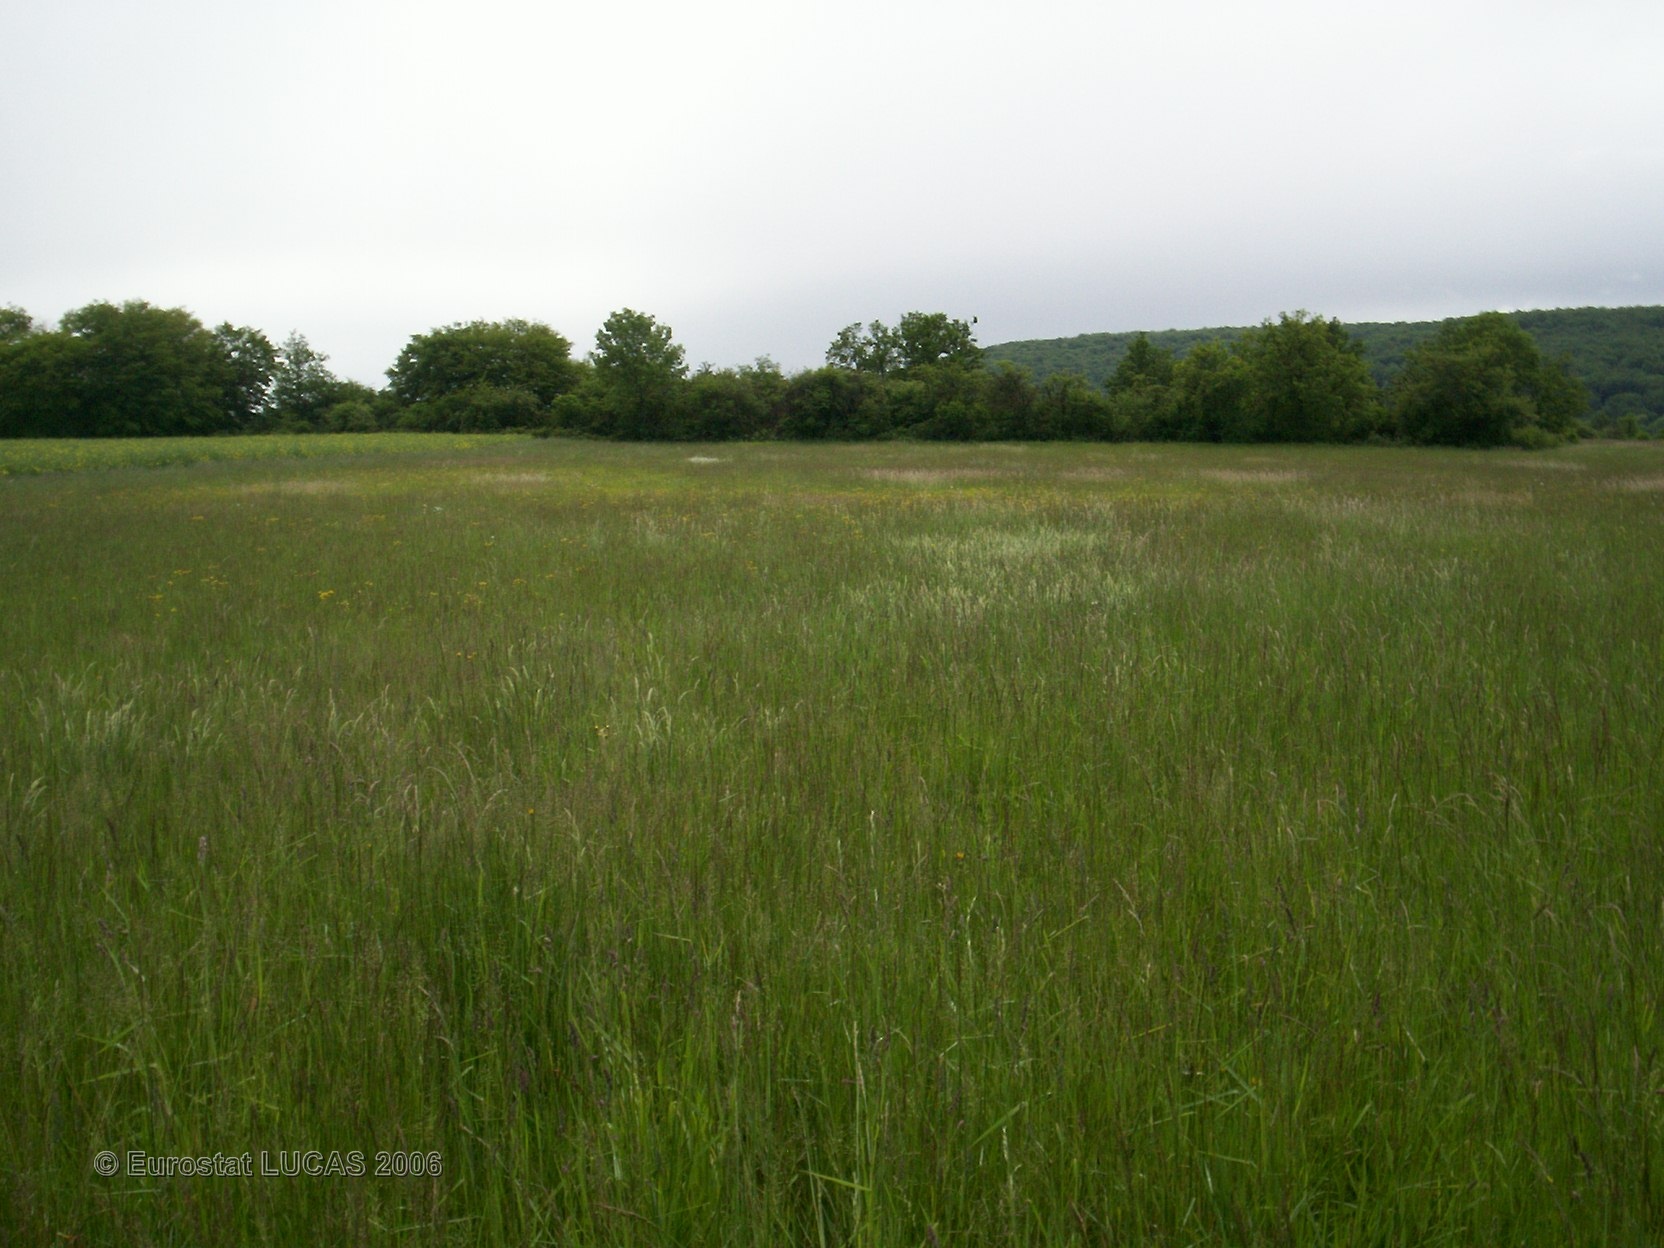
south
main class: Grassland
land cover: Grassland without tree/shrub cover
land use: Agriculture (excluding fallow land and kitchen gardens)
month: May
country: FR
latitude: 47.6597
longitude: 5.0065
